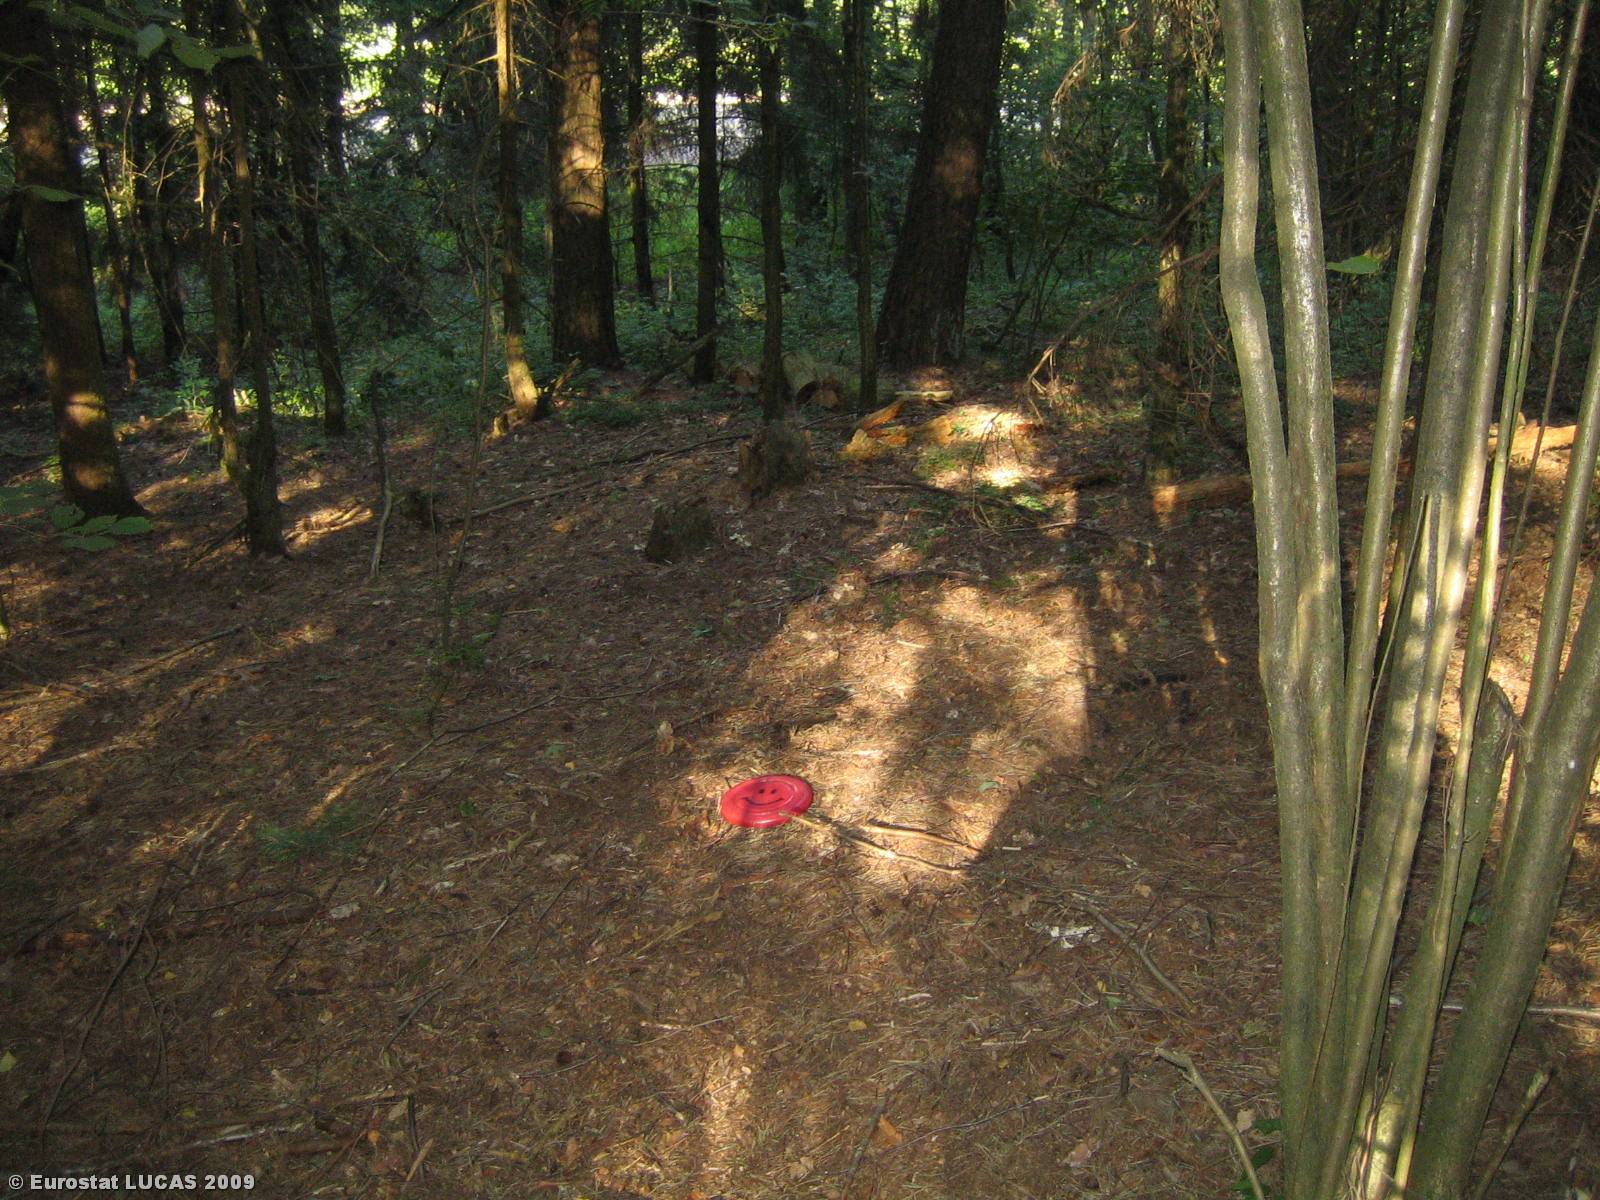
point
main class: Woodland
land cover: Mixed woodland
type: hemiboreal forest and nemoral coniferous forest and mixed broadleaved-coniferous forest
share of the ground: > 75 %
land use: Forestry
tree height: > 5 m
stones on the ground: < 10 %
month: August
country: LT
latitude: 54.8024
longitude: 24.5556
